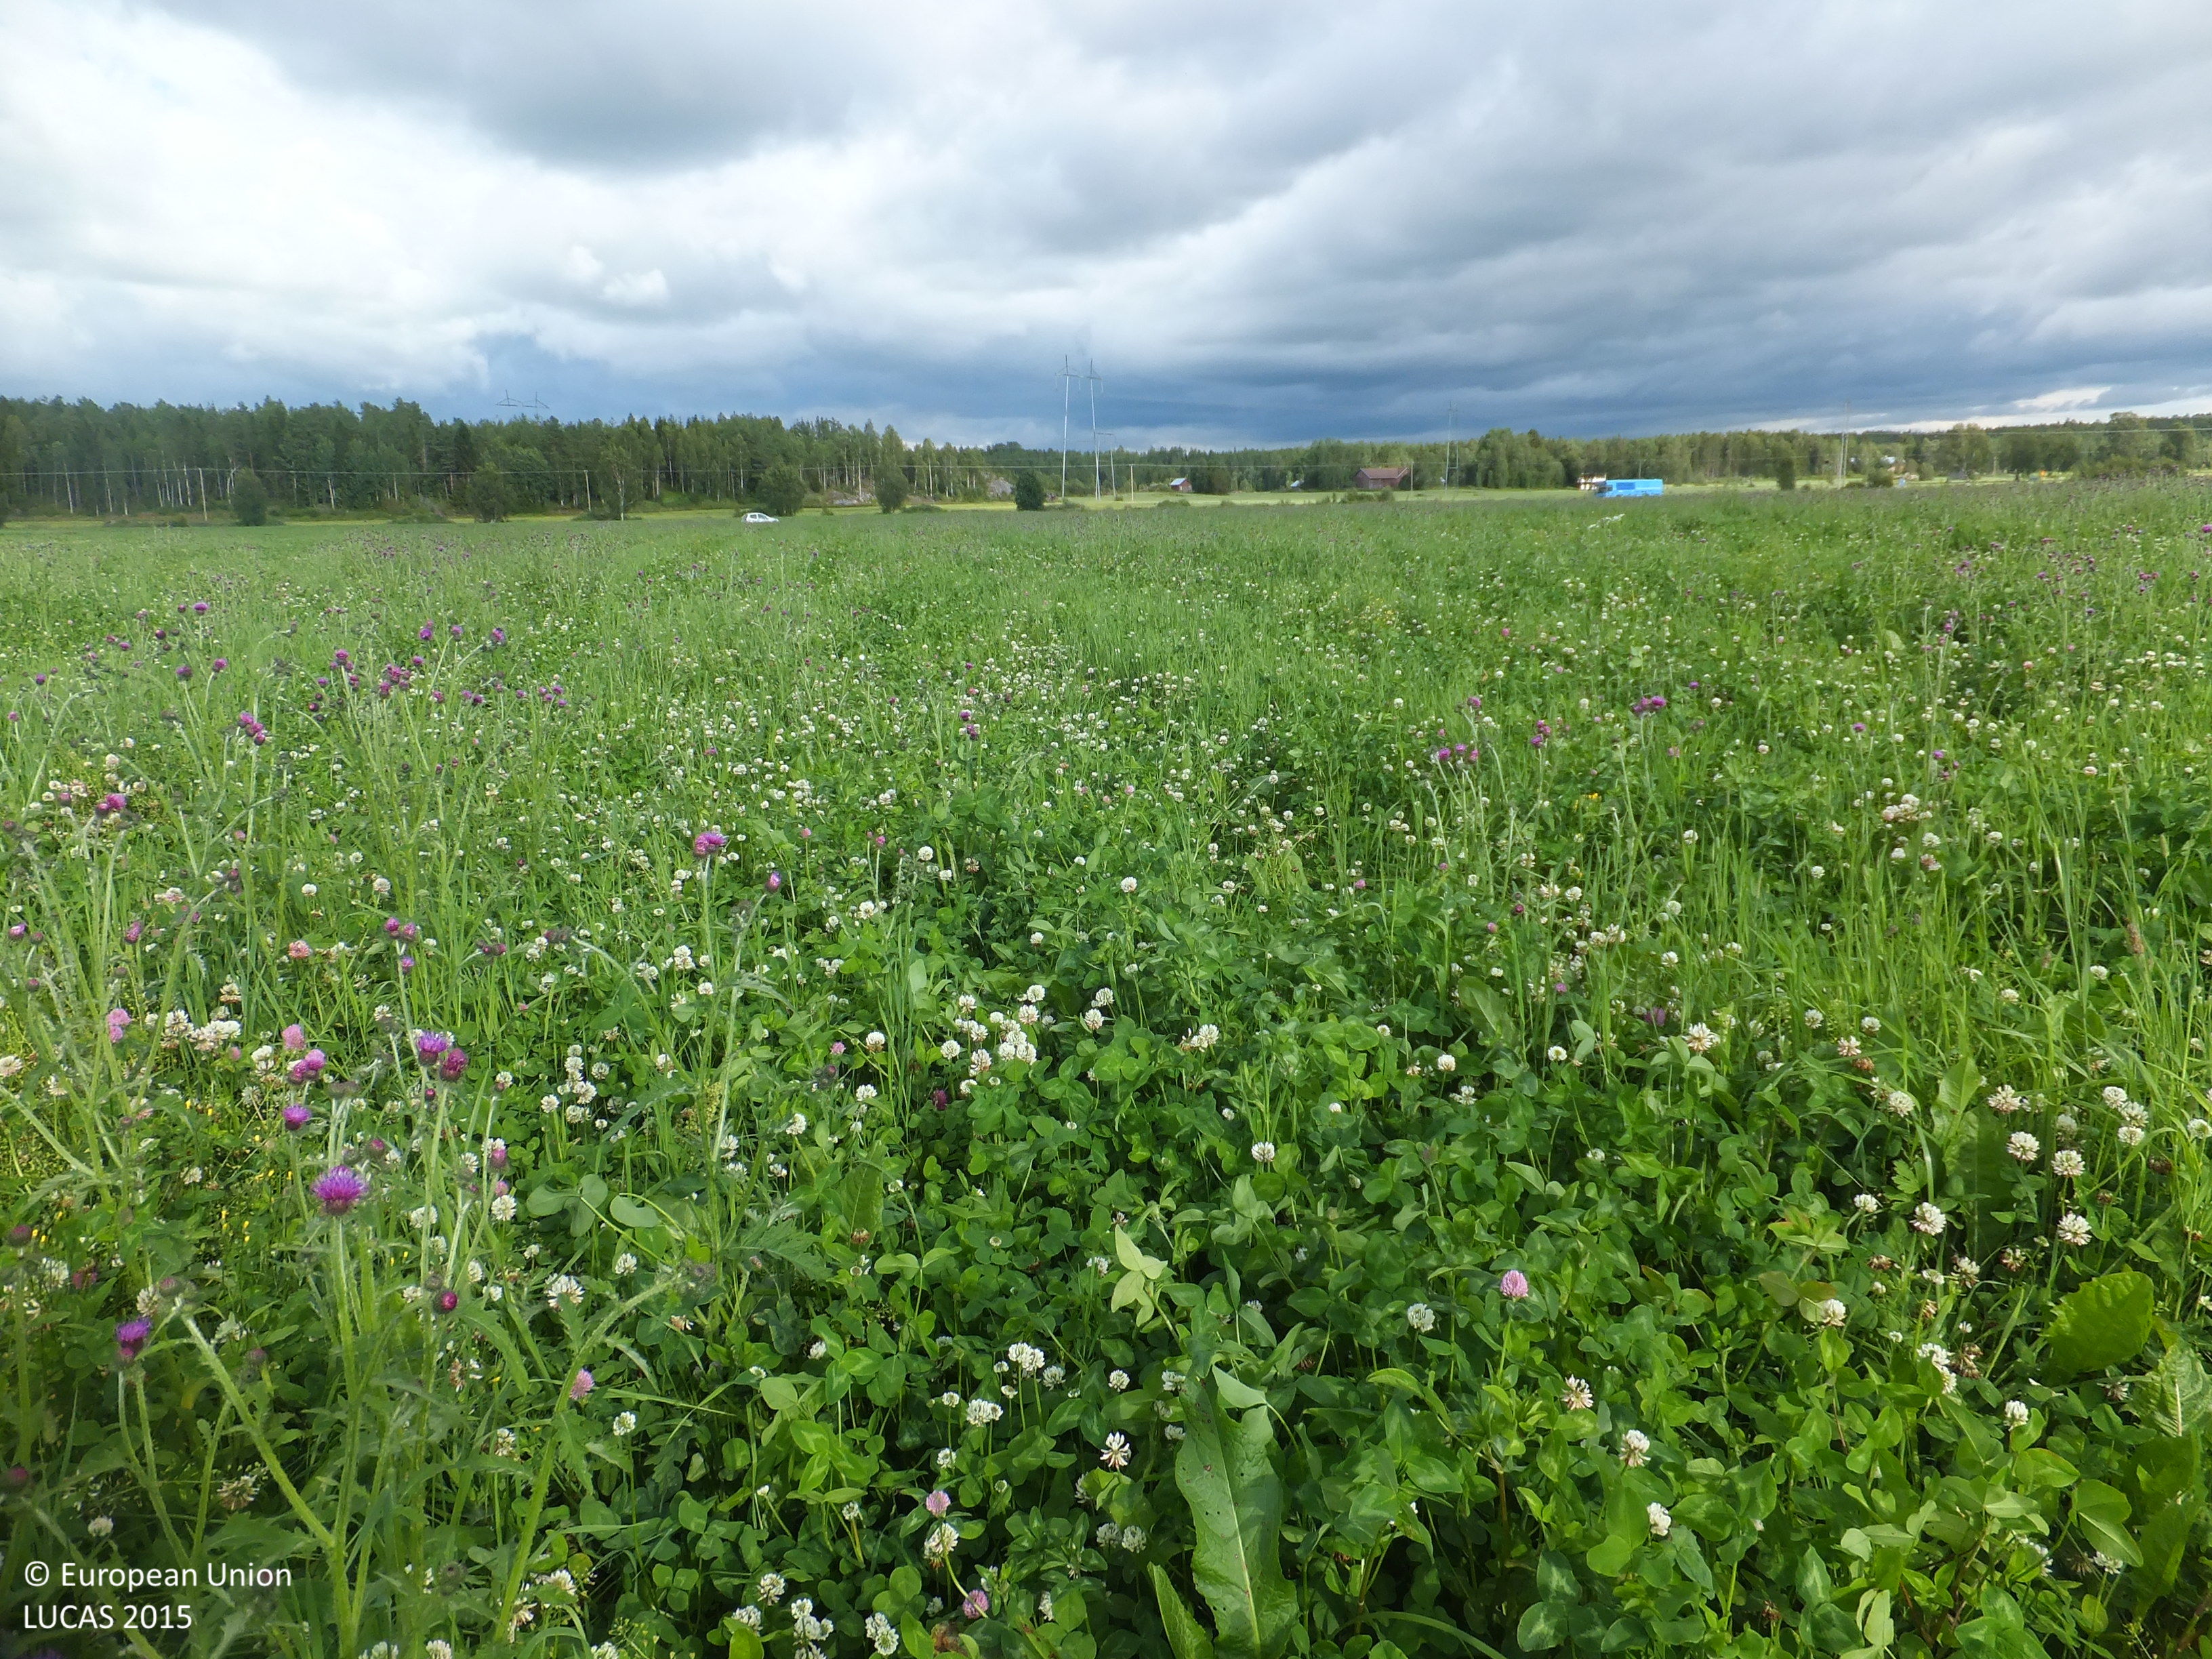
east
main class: Cropland
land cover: Clovers
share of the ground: > 75 %
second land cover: Temporary grasslands
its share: 50 - 75 %
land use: Agriculture (excluding fallow land and kitchen gardens)
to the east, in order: Clovers; Temporary grasslands; Grass margins; Ditches and canals; Grass margins; Paved roads, cycling and walking lanes; Grass margins; Ditches and canals; Temporary grasslands
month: July
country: FI
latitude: 63.1942
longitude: 22.1900
